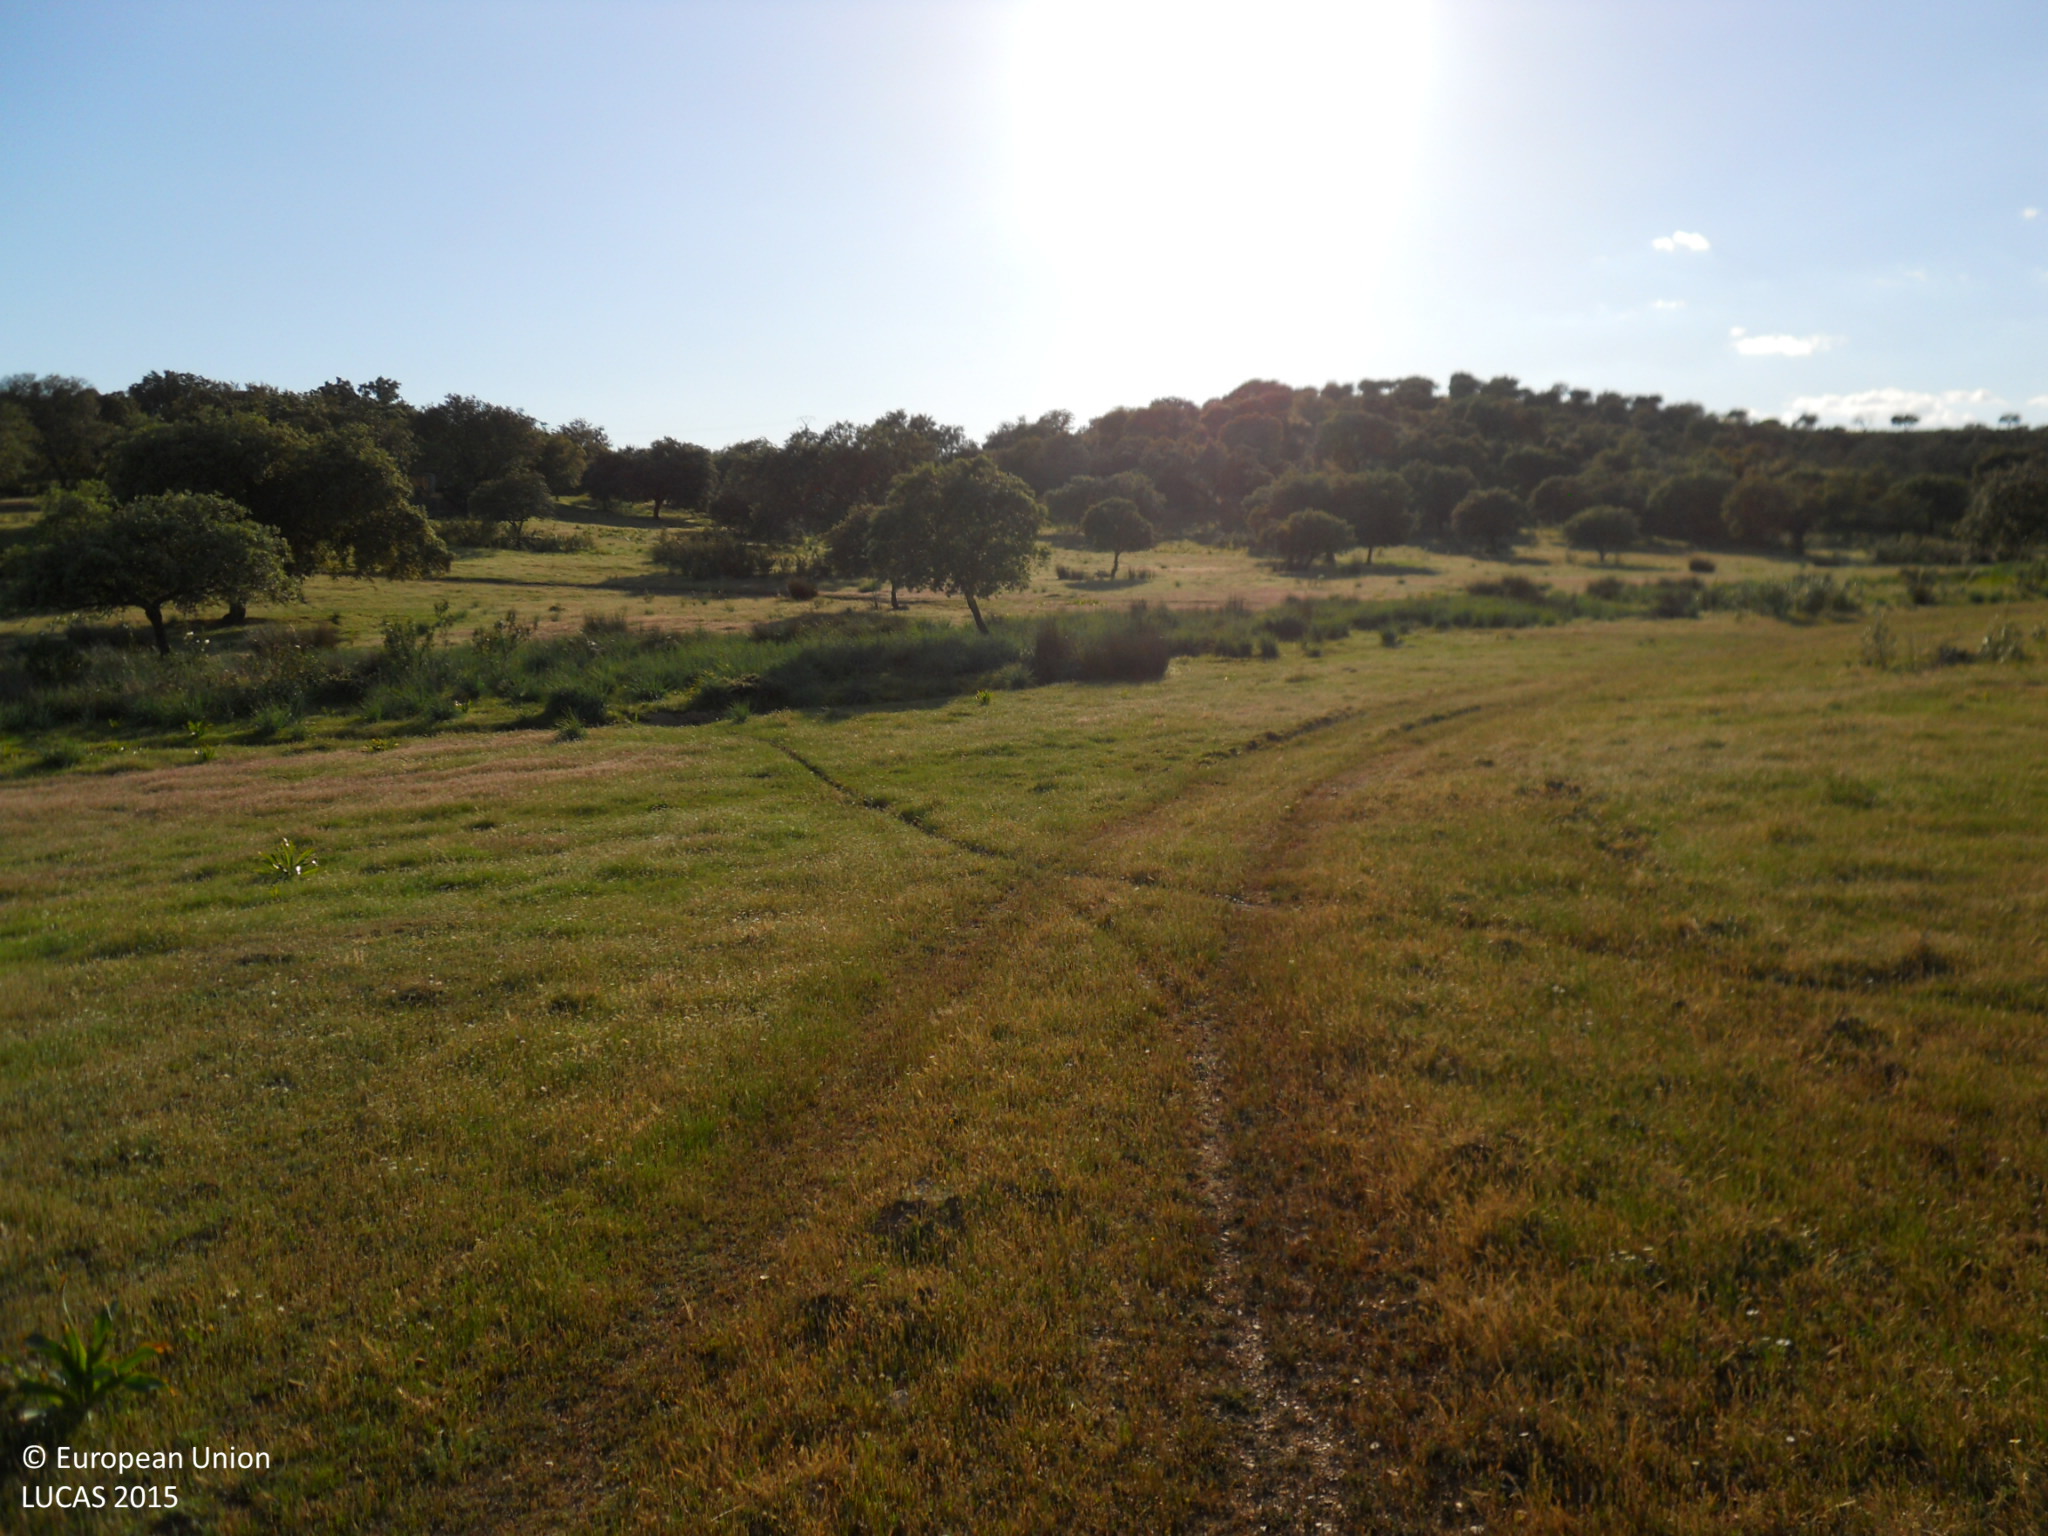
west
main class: Grassland
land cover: Grassland with sparse tree/shrub cover
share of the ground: > 75 %
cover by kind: herbaceous plants 90 %, broadleaved forest trees 5 %, shrubs 5 %
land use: Agriculture (excluding fallow land and kitchen gardens)
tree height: > 5 m
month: April
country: ES
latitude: 39.1984
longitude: -7.0879
